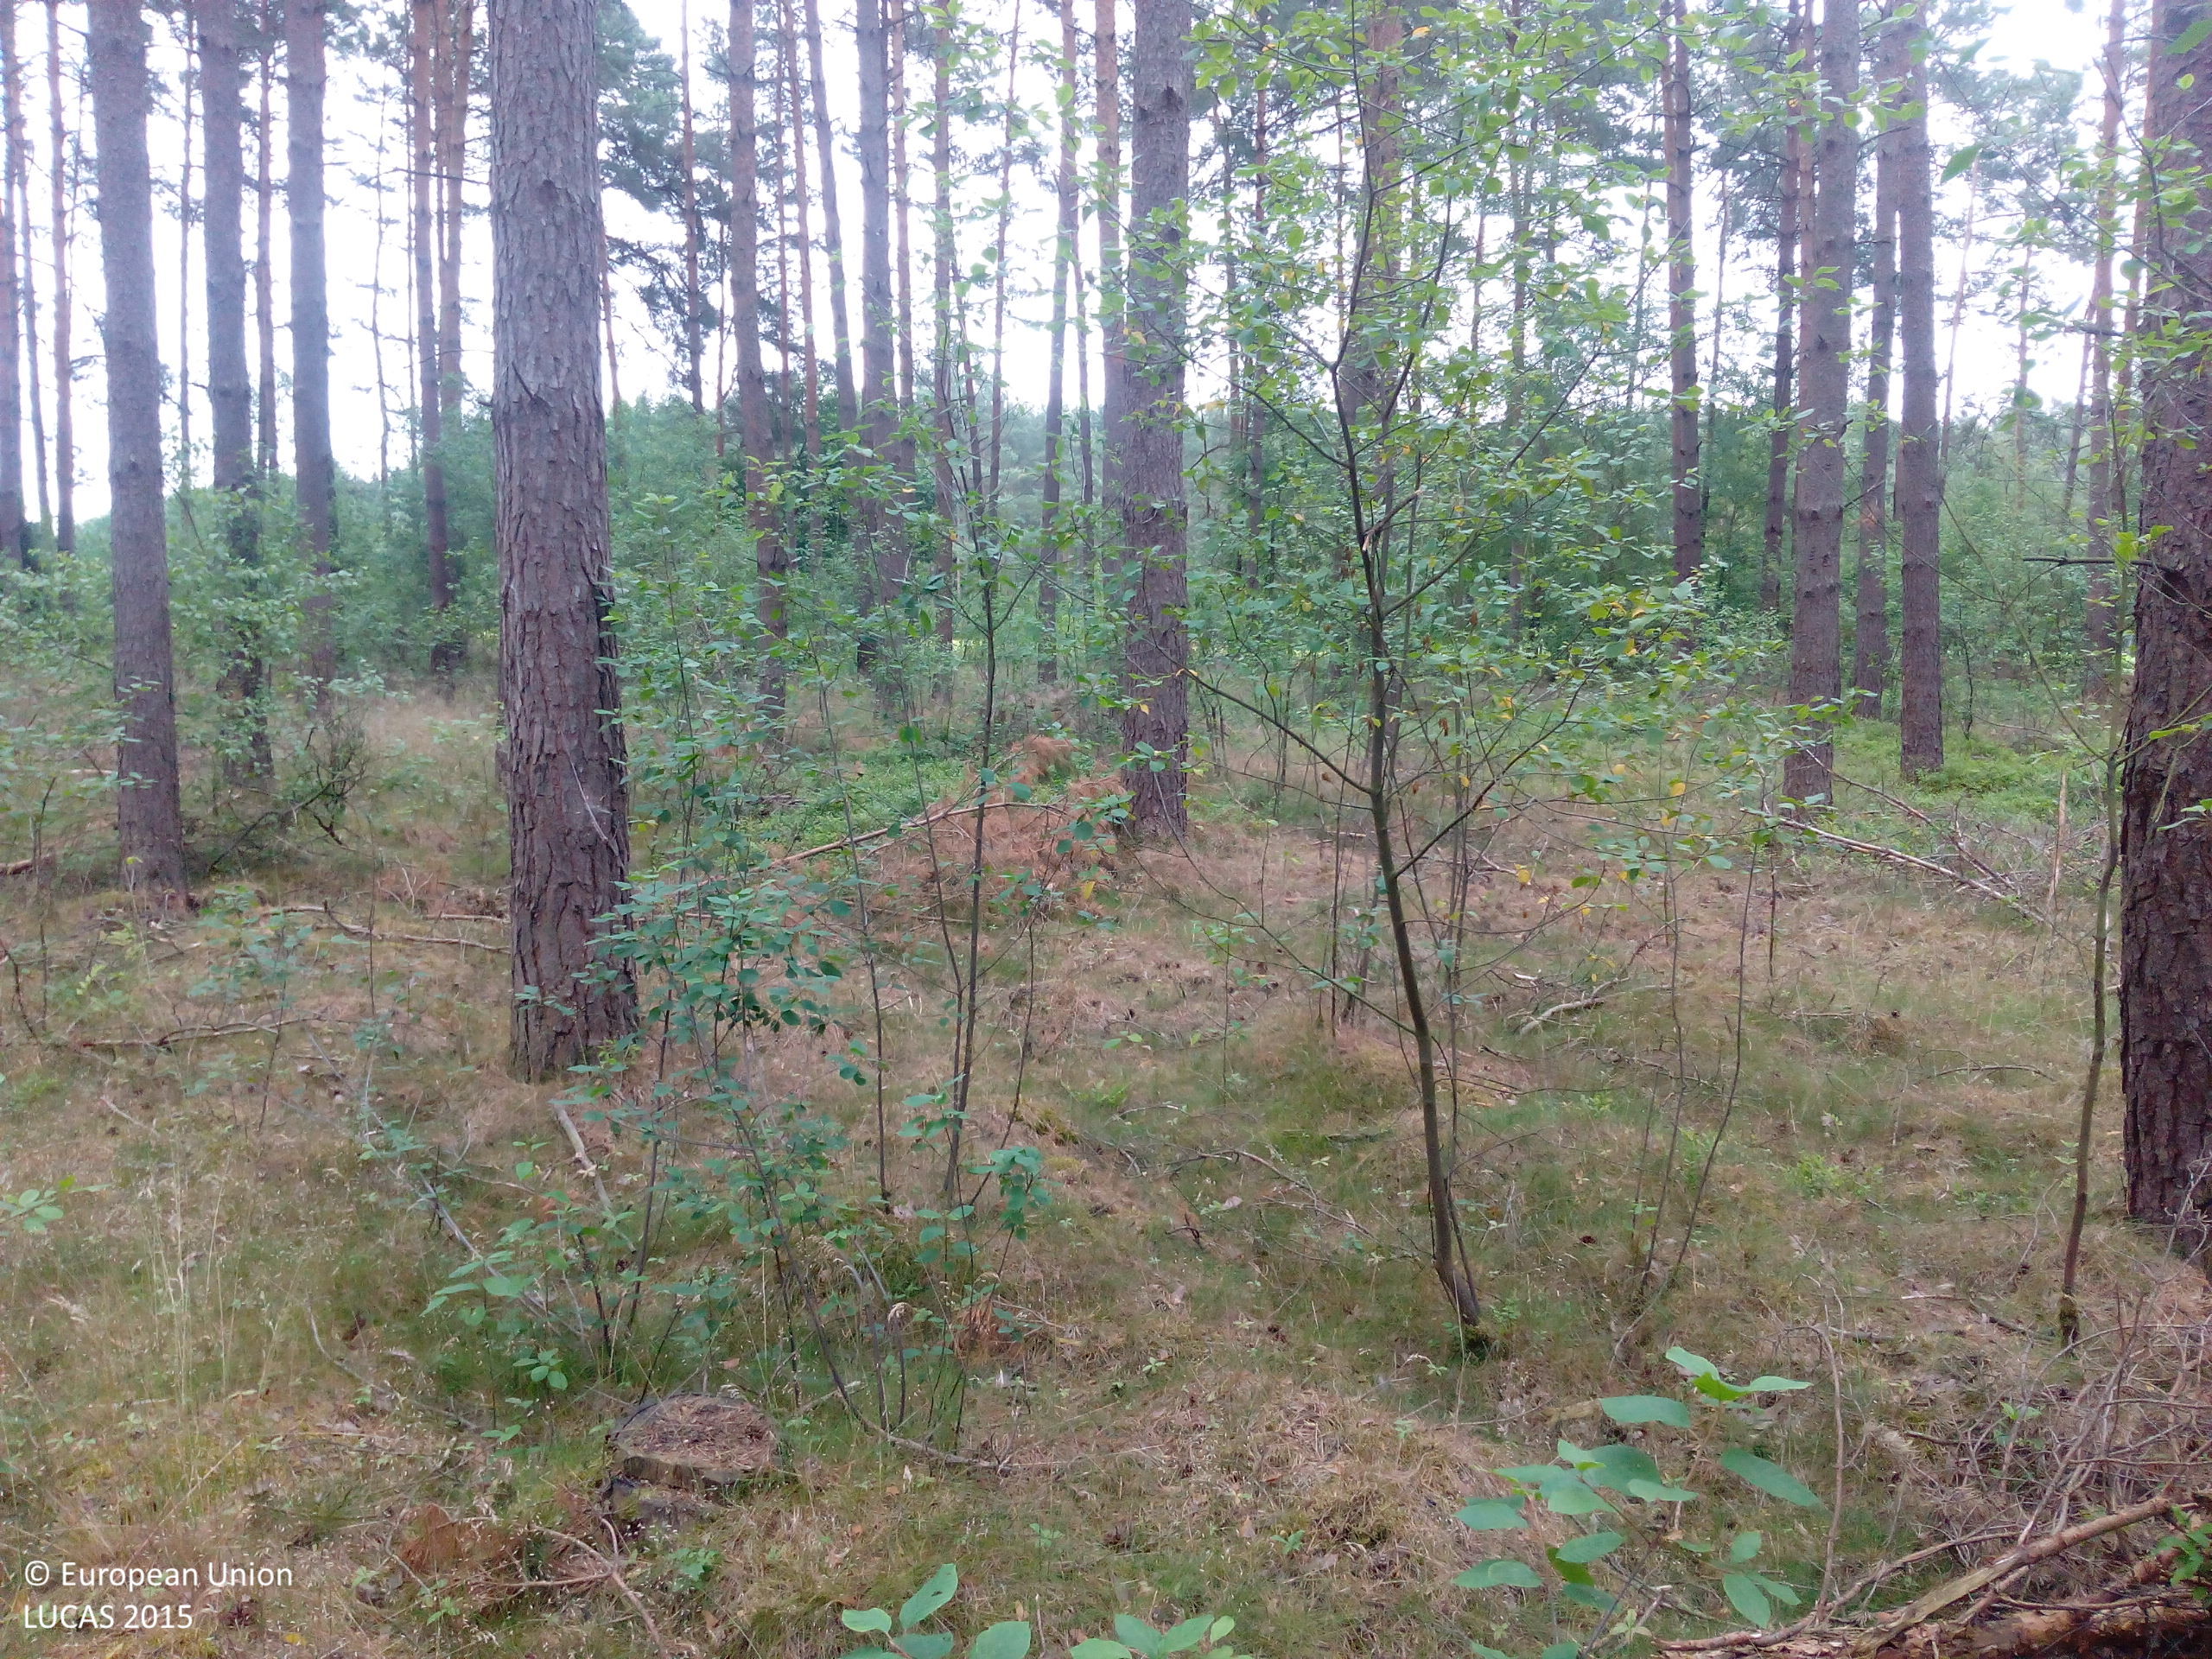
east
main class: Woodland
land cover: Pine dominated coniferous woodland
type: hemiboreal forest and nemoral coniferous forest and mixed broadleaved-coniferous forest
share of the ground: 50 - 75 %
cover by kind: coniferous forest trees 70 %, broadleaved forest trees 15 %, herbaceous plants 15 %
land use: Forestry
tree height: > 5 m
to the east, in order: Pine dominated coniferous woodland; Tracks; Pine dominated mixed woodland; Barley; Grass margins; Tracks; Grass margins; Pine dominated mixed woodland
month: July
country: DE
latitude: 52.7007
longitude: 10.2811
